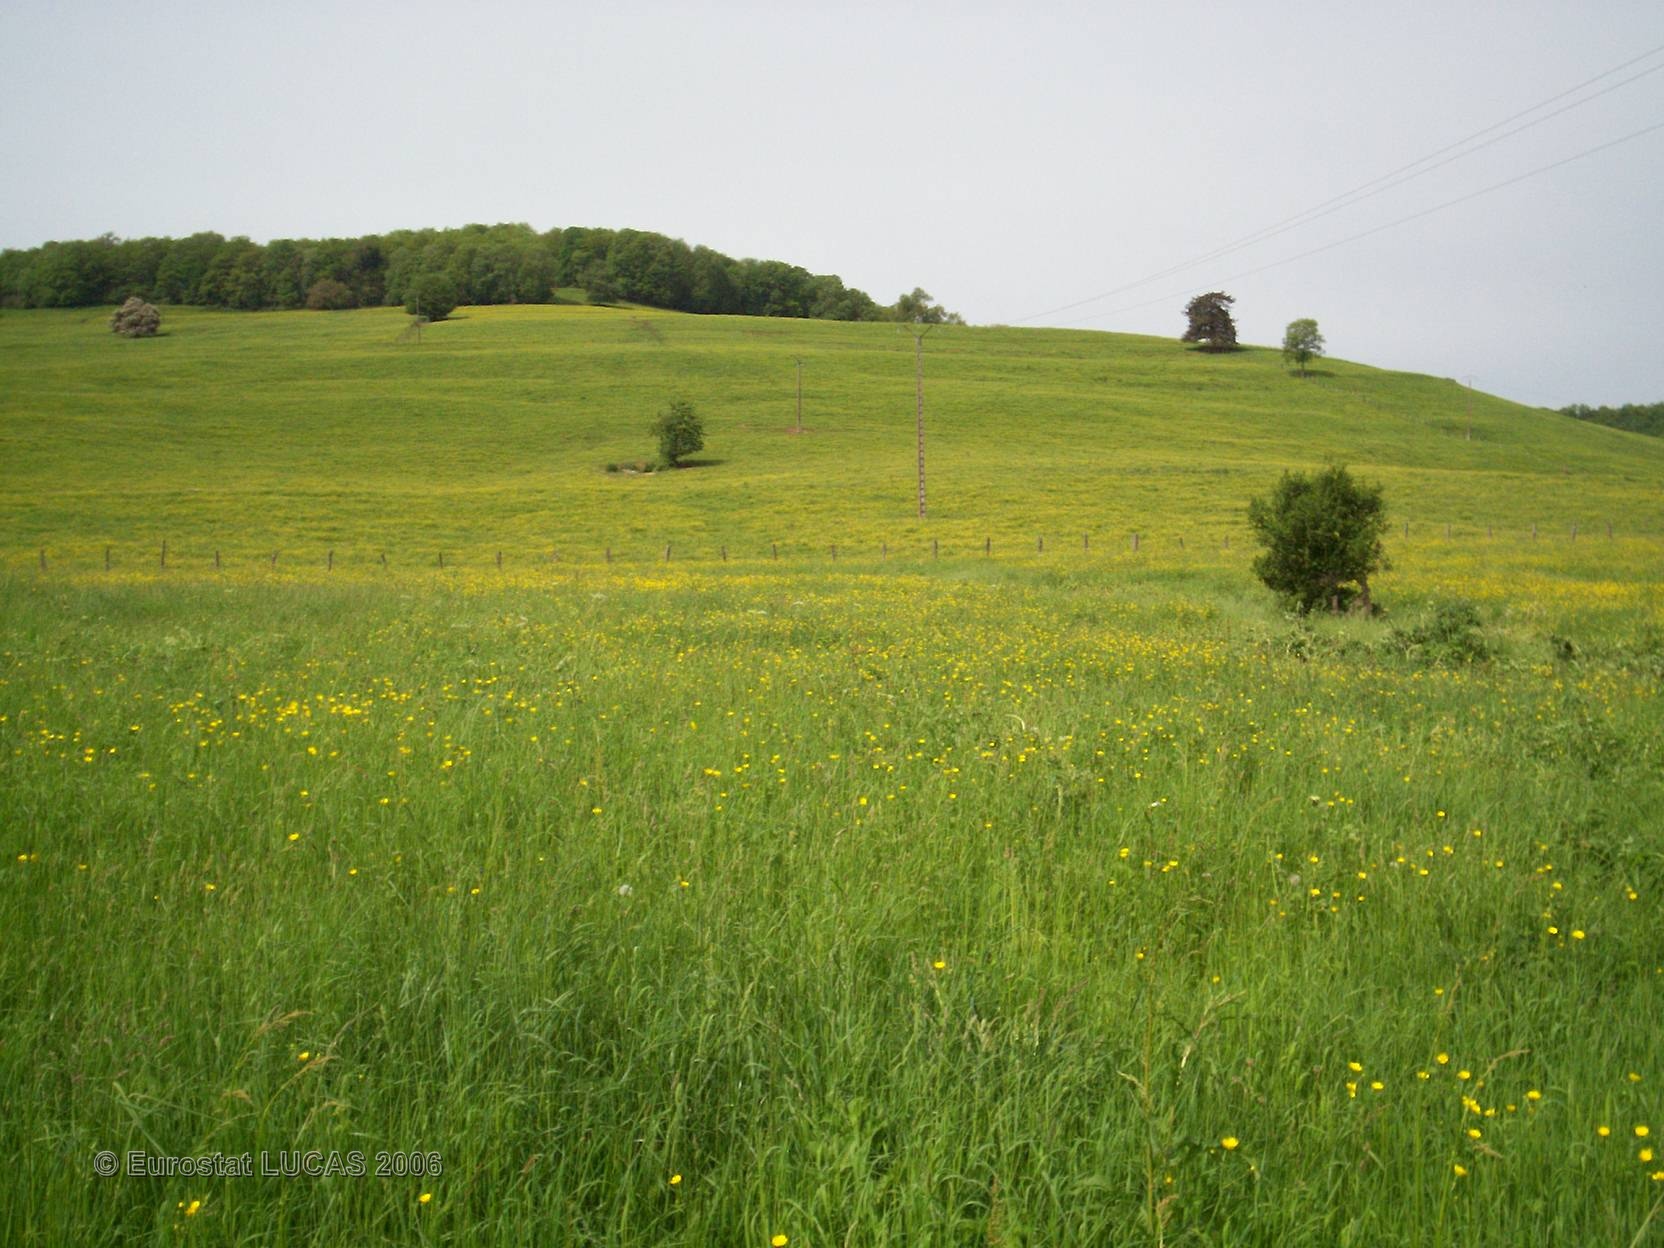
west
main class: Grassland
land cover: Grassland without tree/shrub cover
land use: Agriculture (excluding fallow land and kitchen gardens)
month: May
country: FR
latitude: 47.3676
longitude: 4.5570
